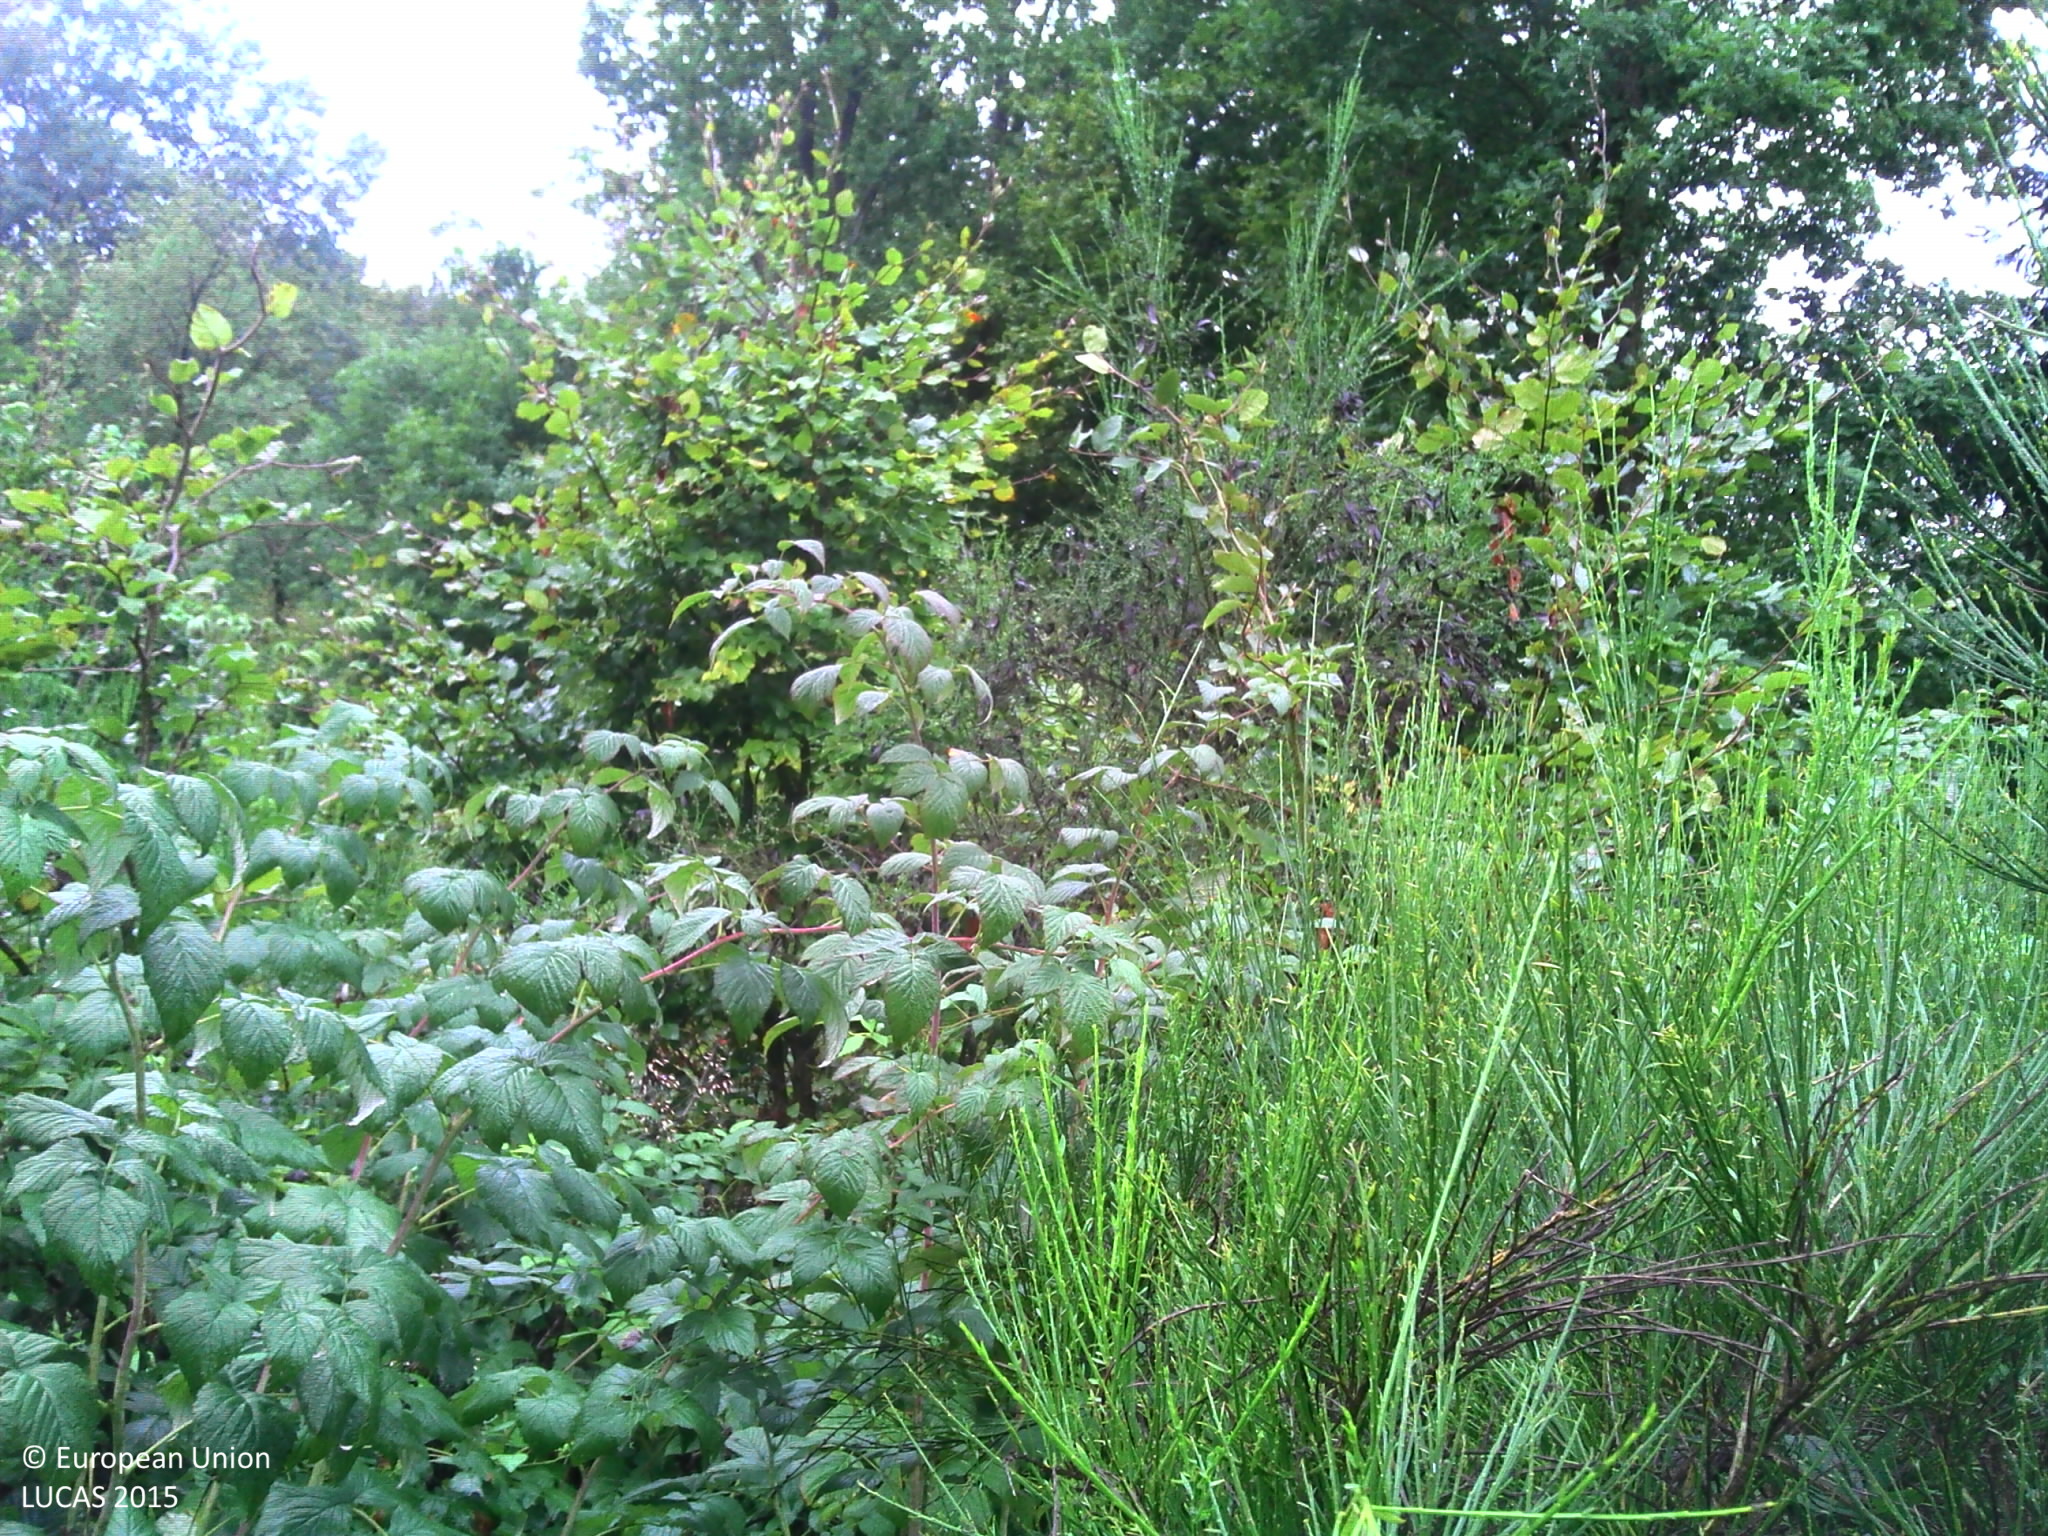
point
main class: Shrubland
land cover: Shrubland with sparse tree cover
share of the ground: > 75 %
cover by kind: shrubs 95 %, broadleaved forest trees 5 %
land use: Forestry
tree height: < 5 m
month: September
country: LU
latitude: 49.8045
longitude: 5.9001
